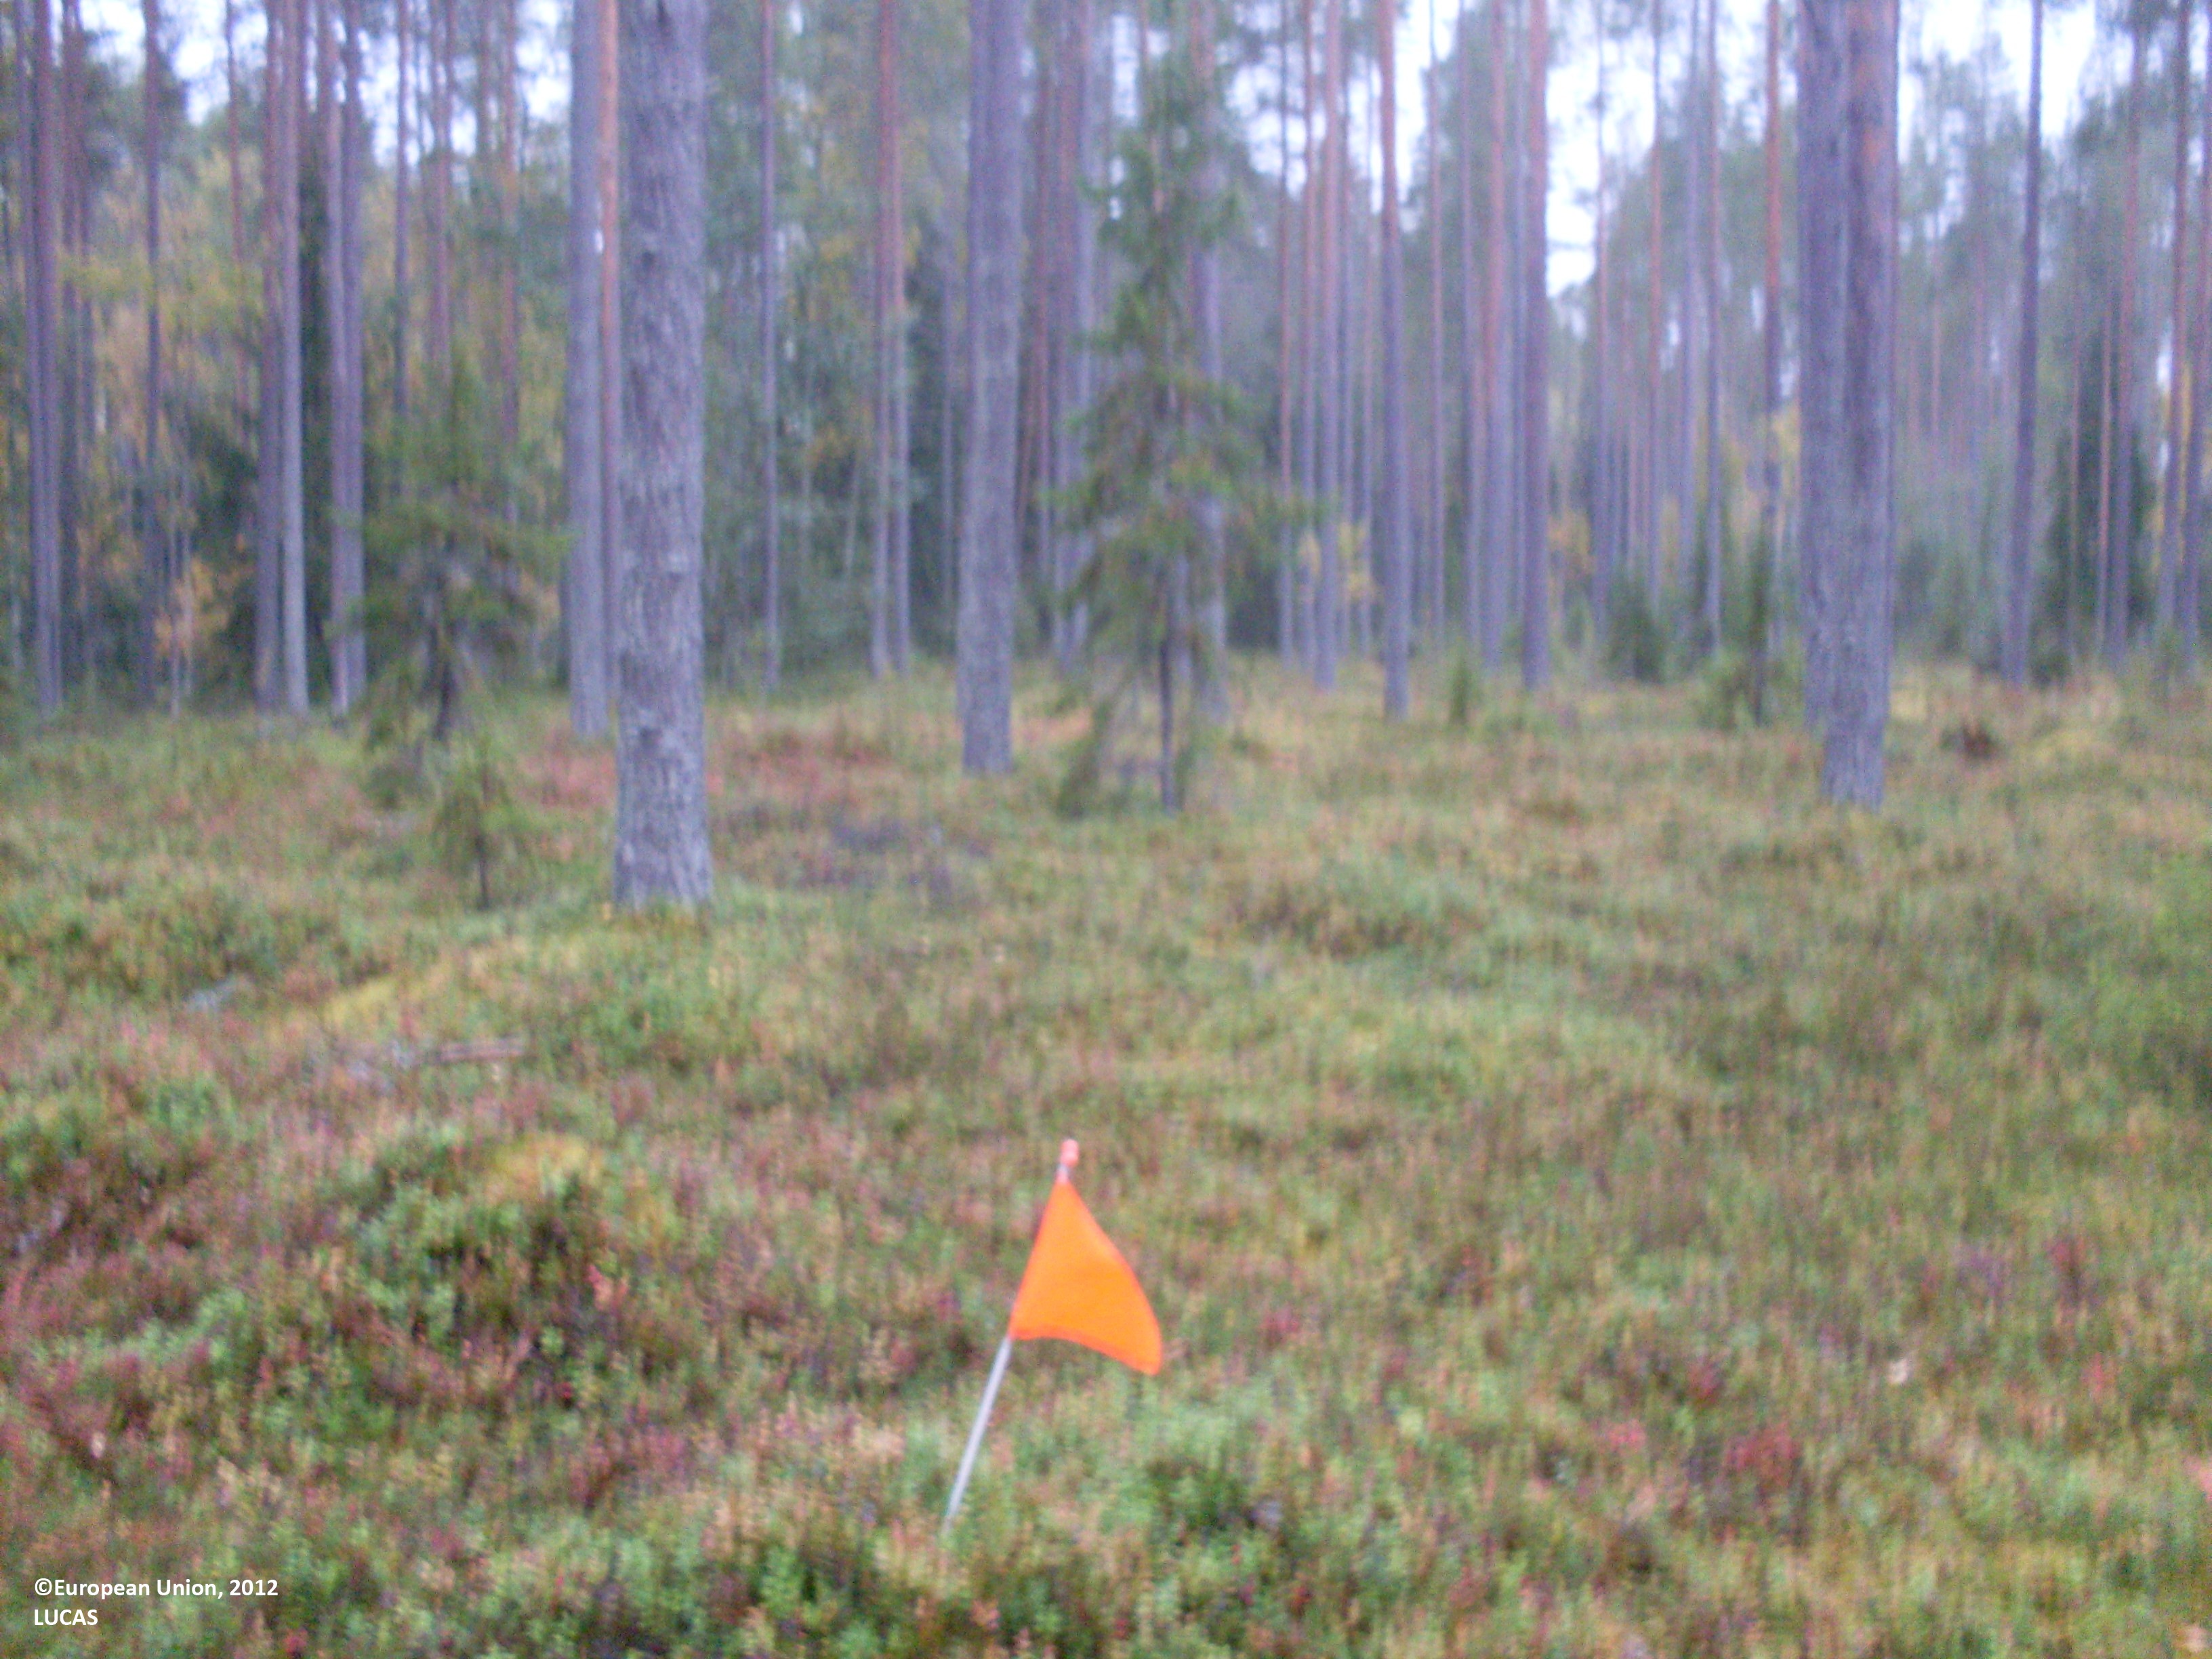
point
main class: Woodland
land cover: Pine dominated coniferous woodland
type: boreal forest
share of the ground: 25 - 50 %
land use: Forestry
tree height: > 5 m
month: September
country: FI
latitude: 64.1698
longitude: 28.9790
